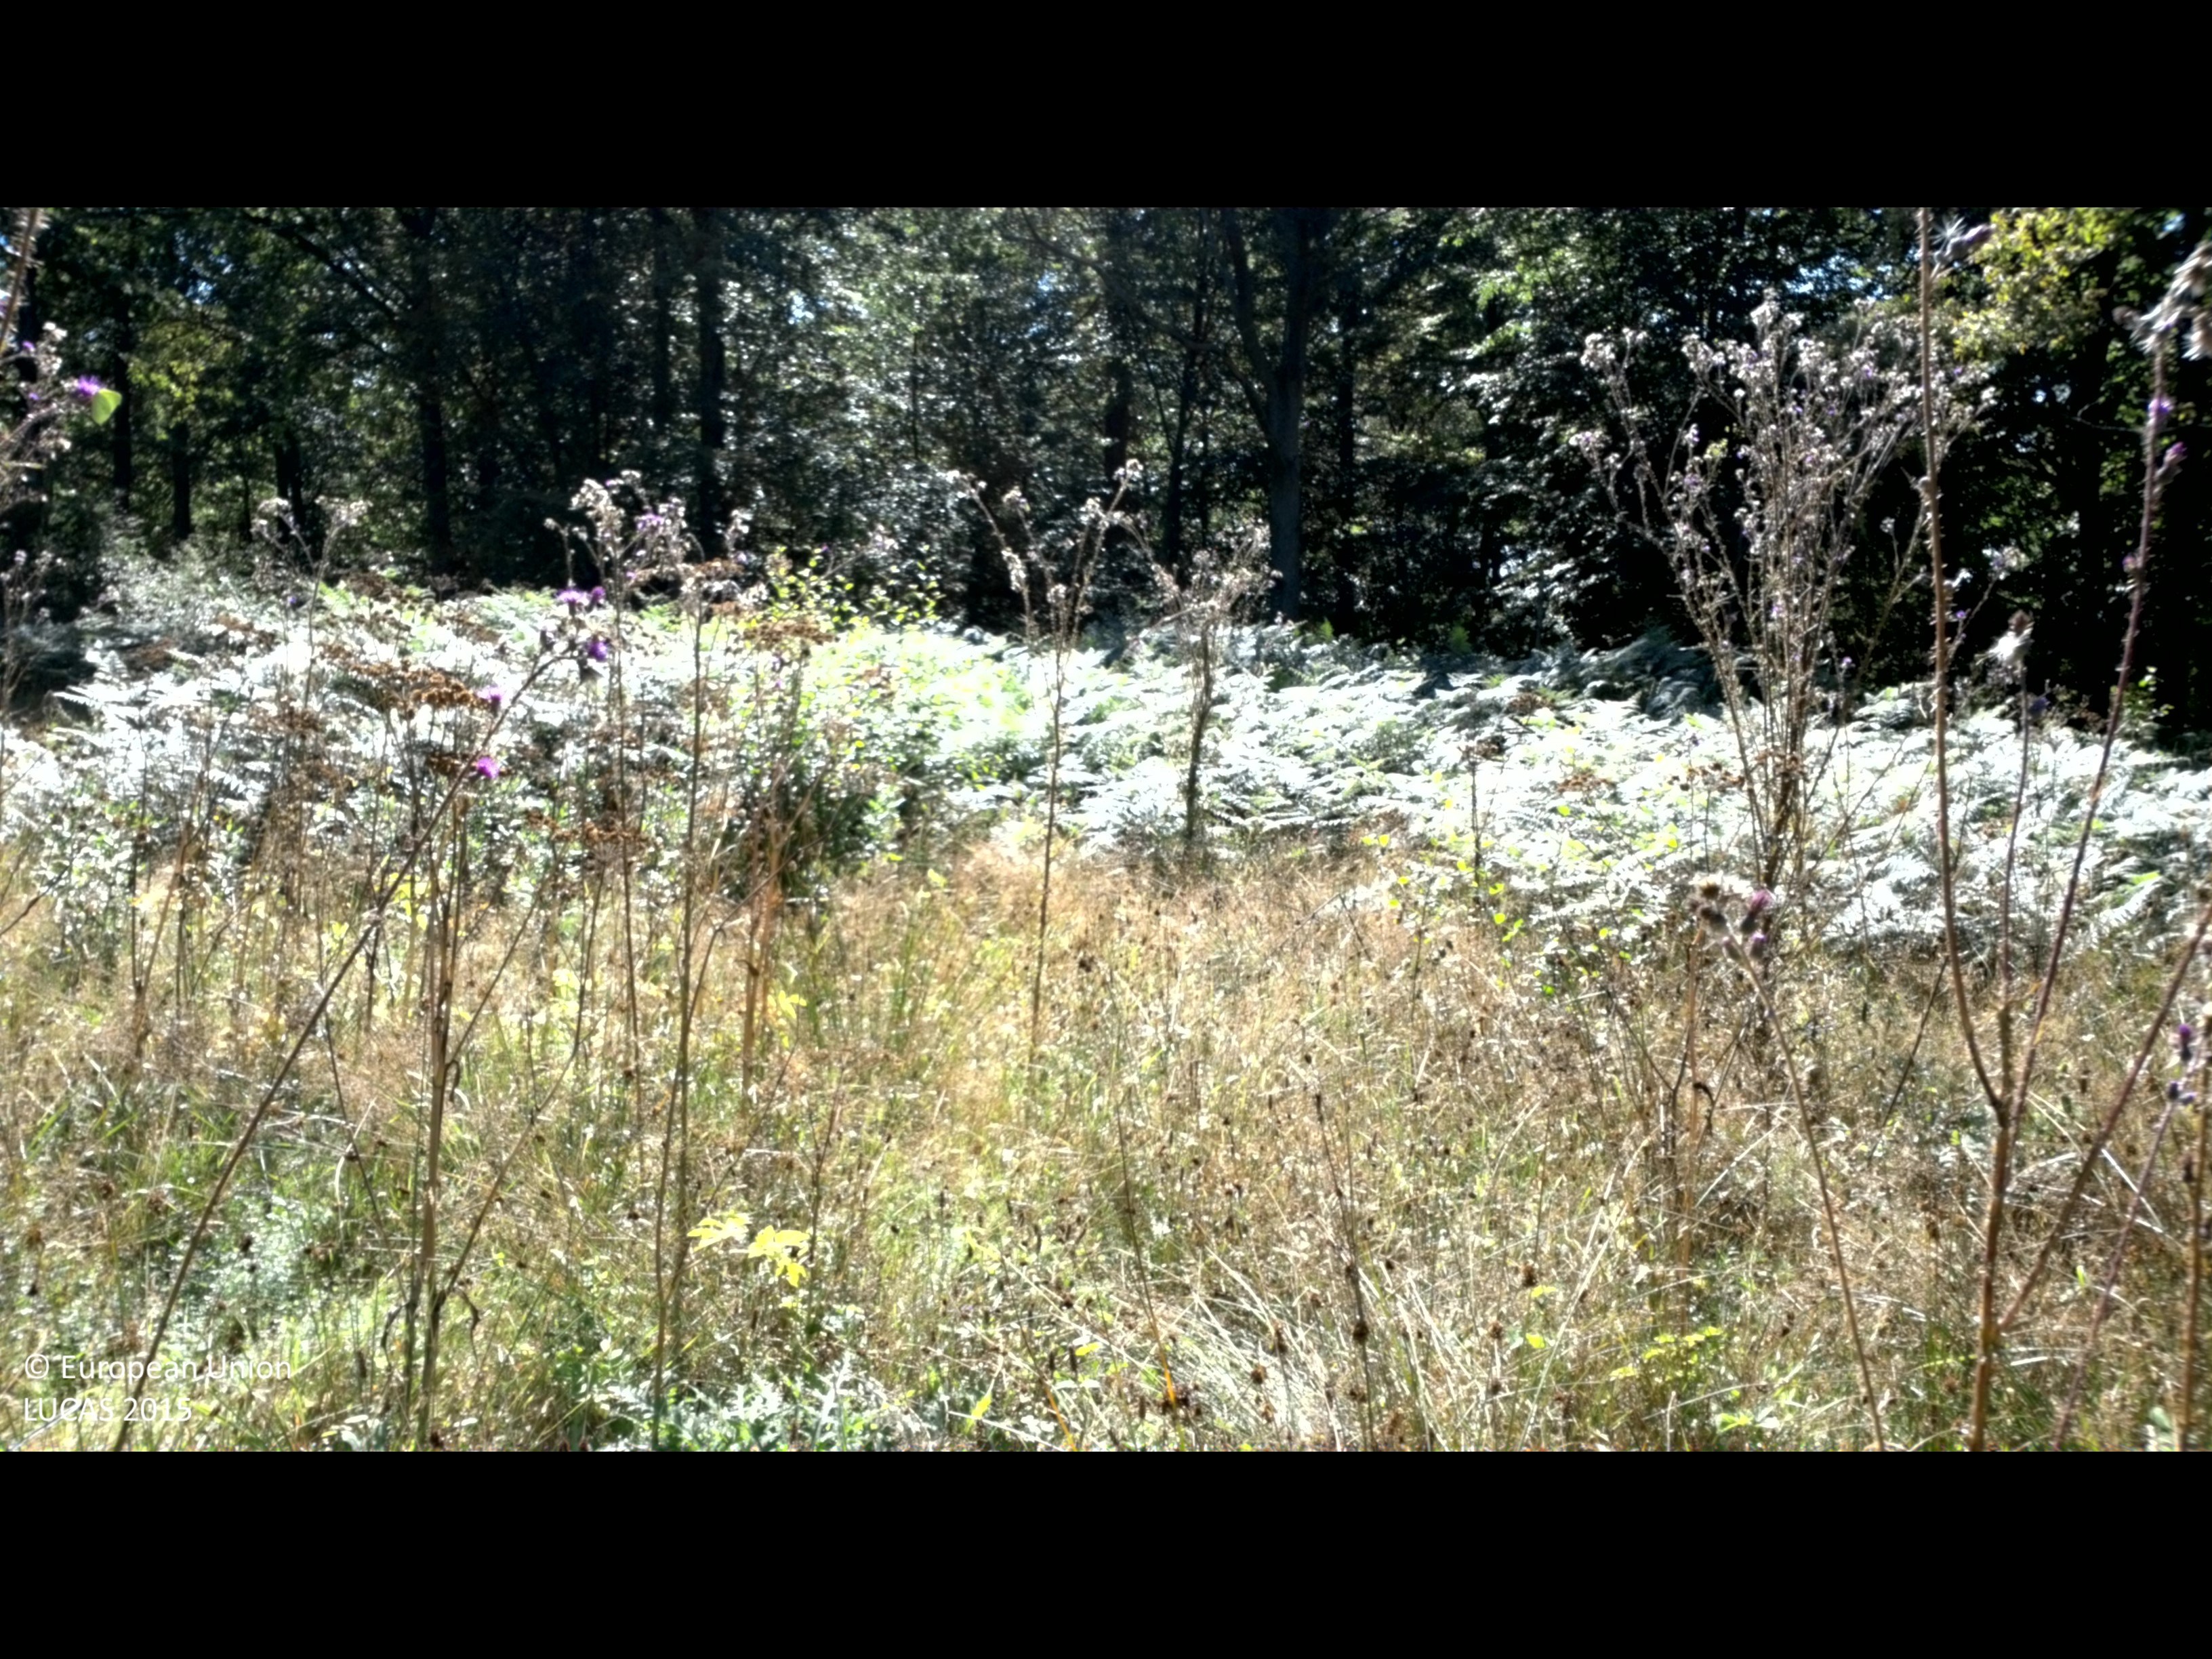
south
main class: Grassland
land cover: Grassland without tree/shrub cover
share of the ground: > 75 %
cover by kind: herbaceous plants 100 %
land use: Semi-natural and natural areas not in use
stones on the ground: < 10 %
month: August
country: SE
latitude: 56.1613
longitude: 15.8778
